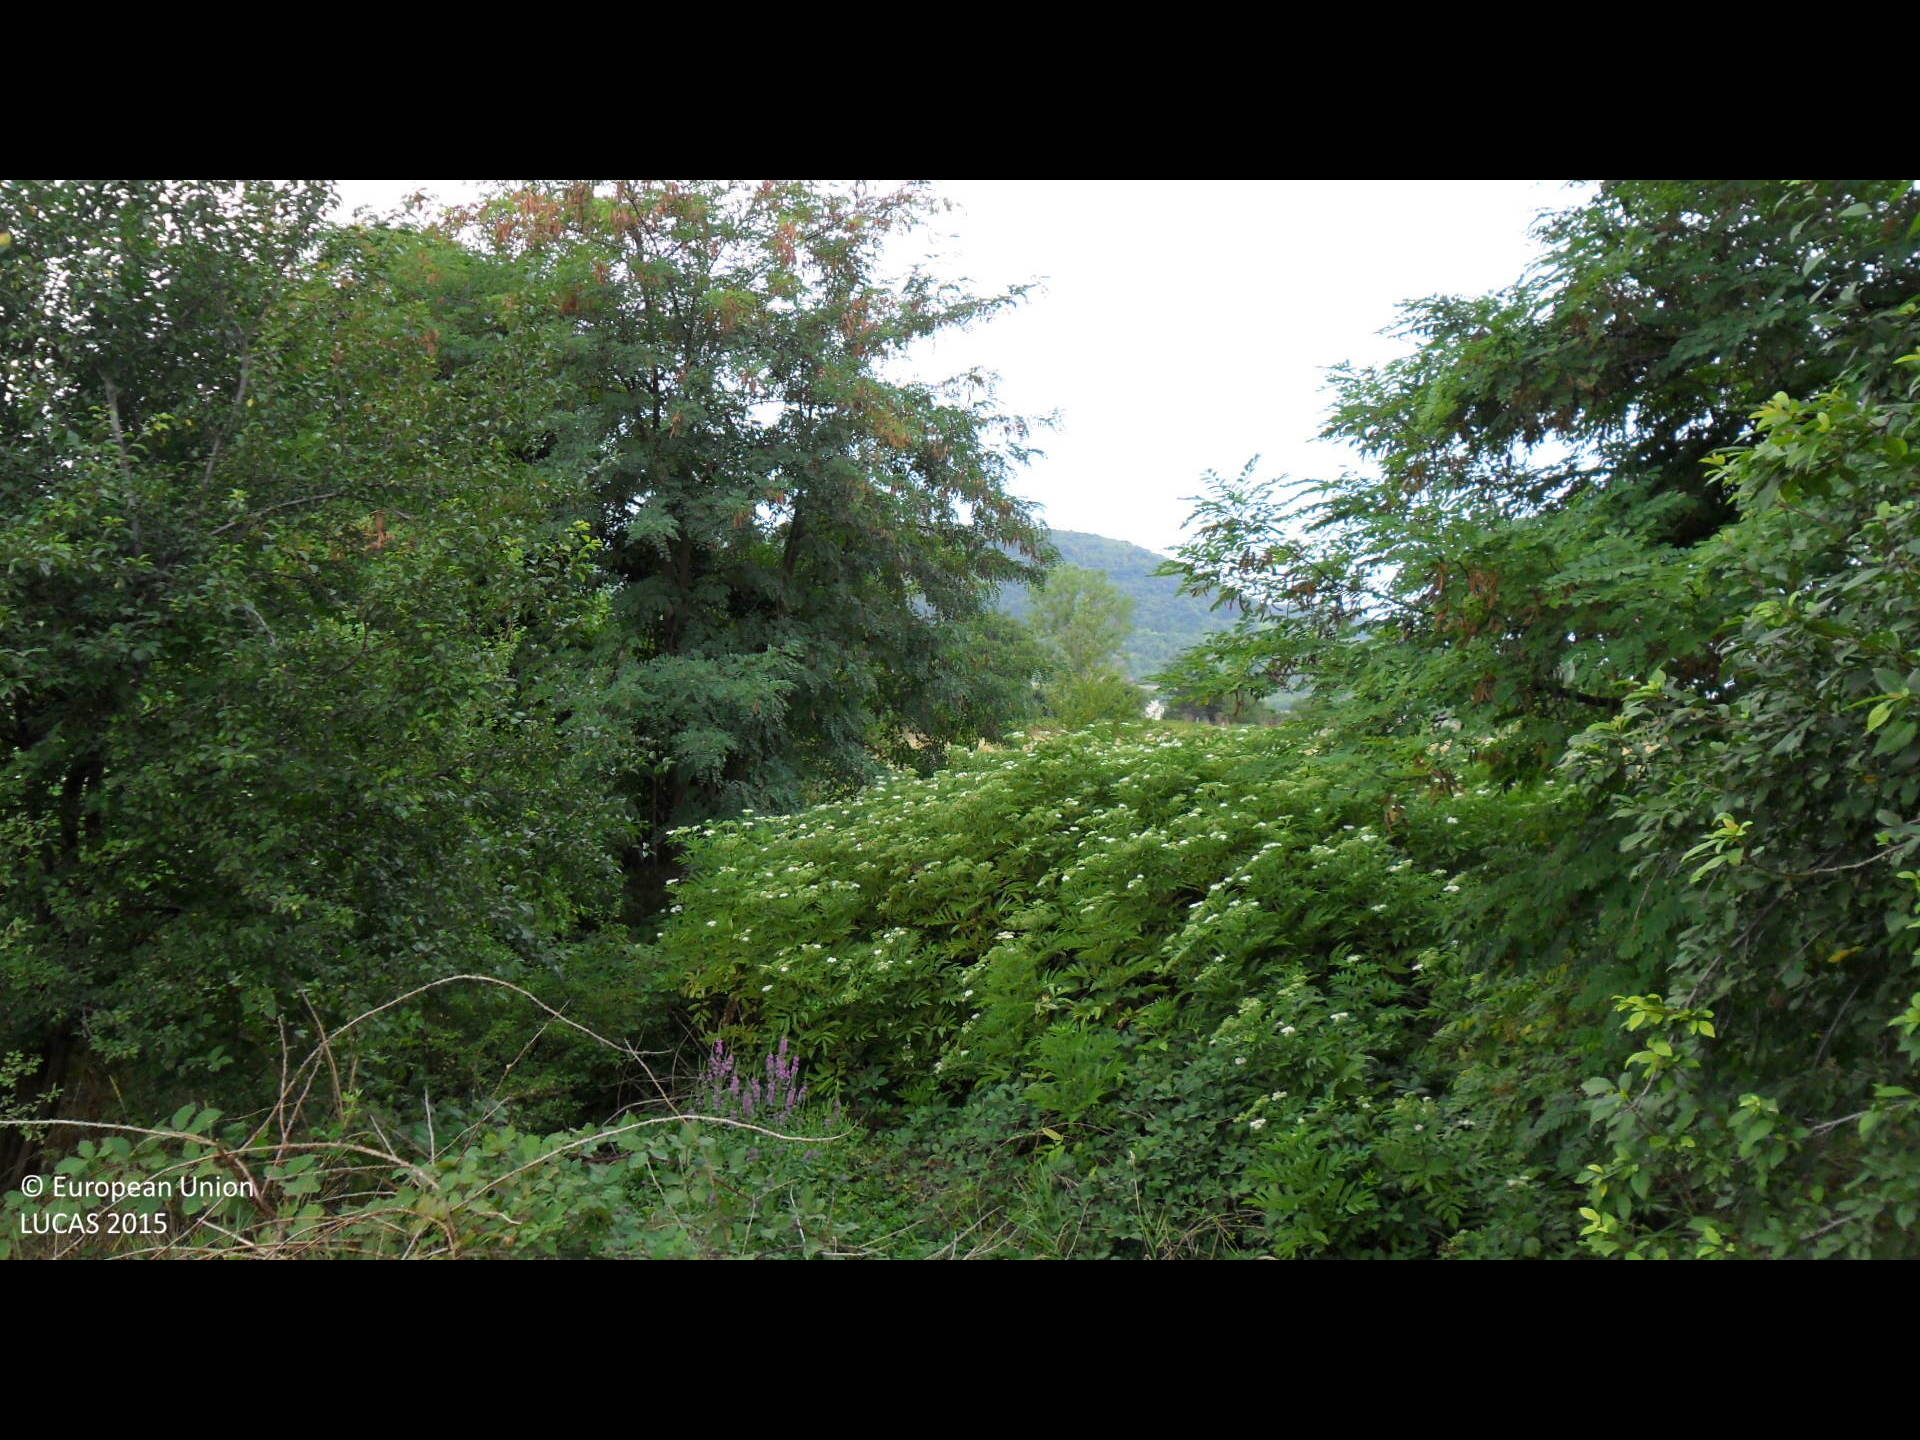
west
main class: Shrubland
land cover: Shrubland with sparse tree cover
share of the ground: > 75 %
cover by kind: shrubs 95 %, broadleaved forest trees 5 %
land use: Semi-natural and natural areas not in use
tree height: < 5 m
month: August
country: BG
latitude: 43.4571
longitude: 26.1750
